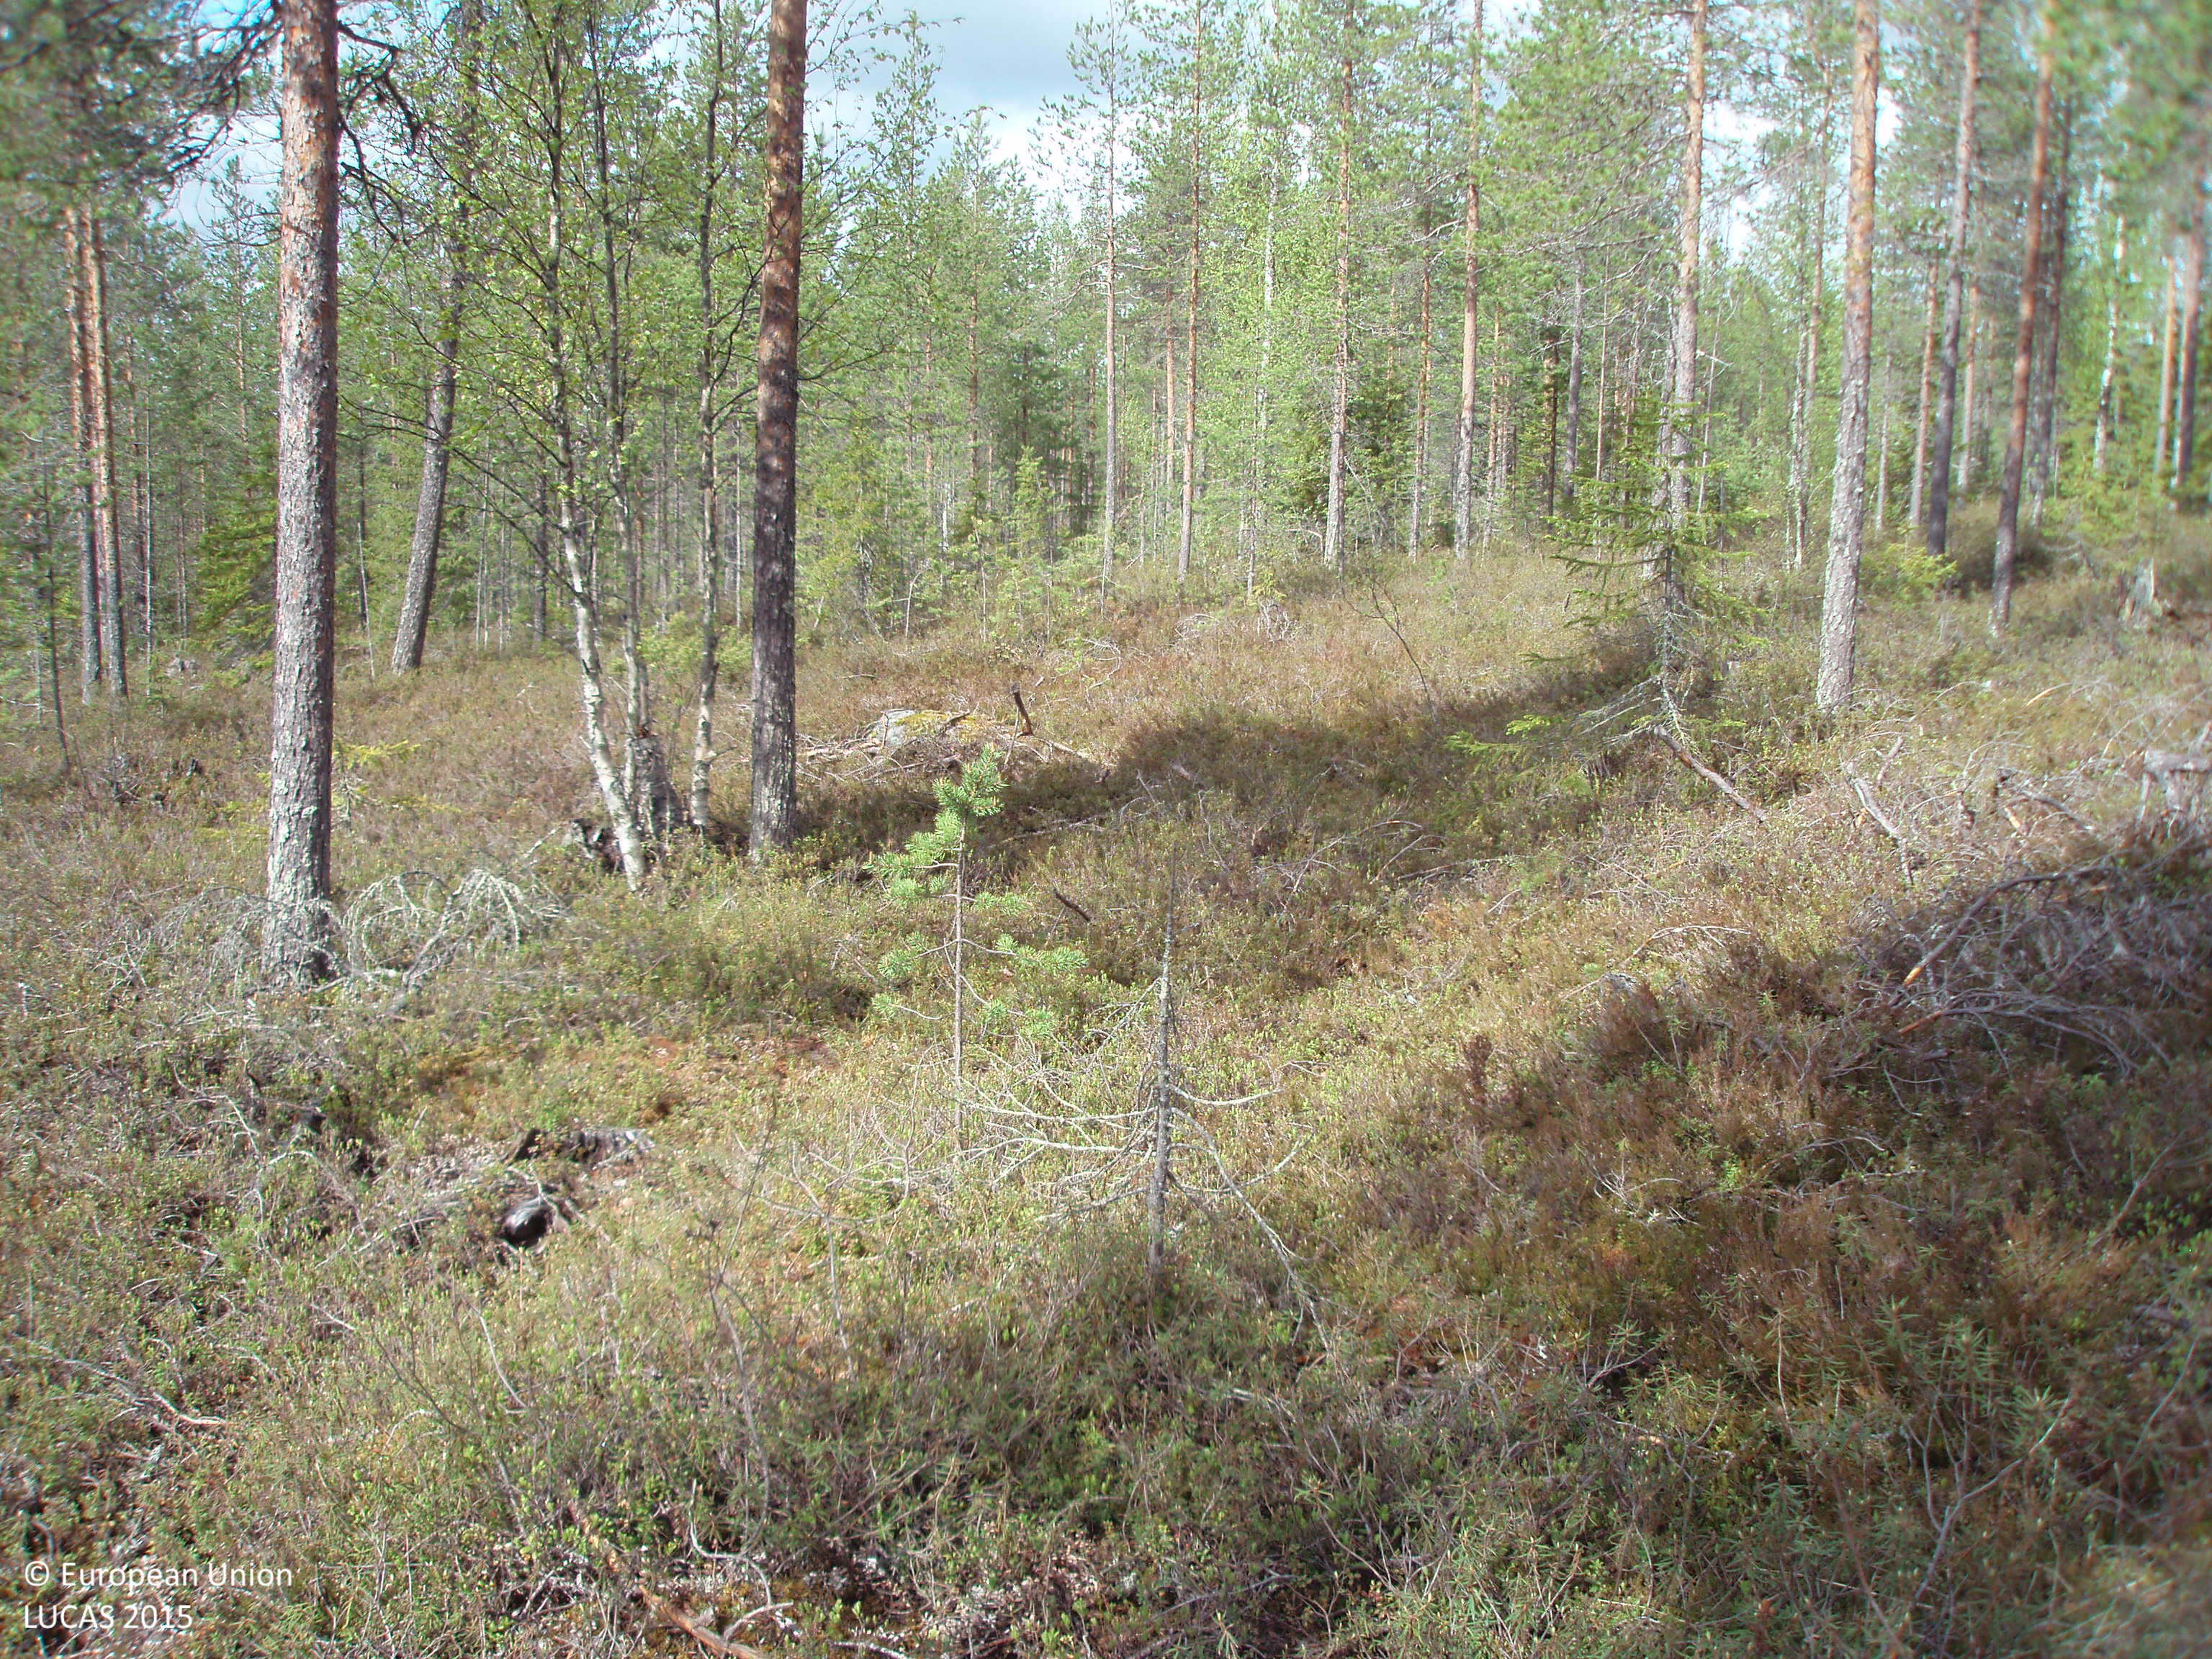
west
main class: Woodland
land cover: Pine dominated coniferous woodland
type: boreal forest
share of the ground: 50 - 75 %
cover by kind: coniferous forest trees 60 %, shrubs 35 %, broadleaved forest trees 5 %
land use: Forestry
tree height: > 5 m
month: June
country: FI
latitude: 66.4517
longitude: 27.3139
